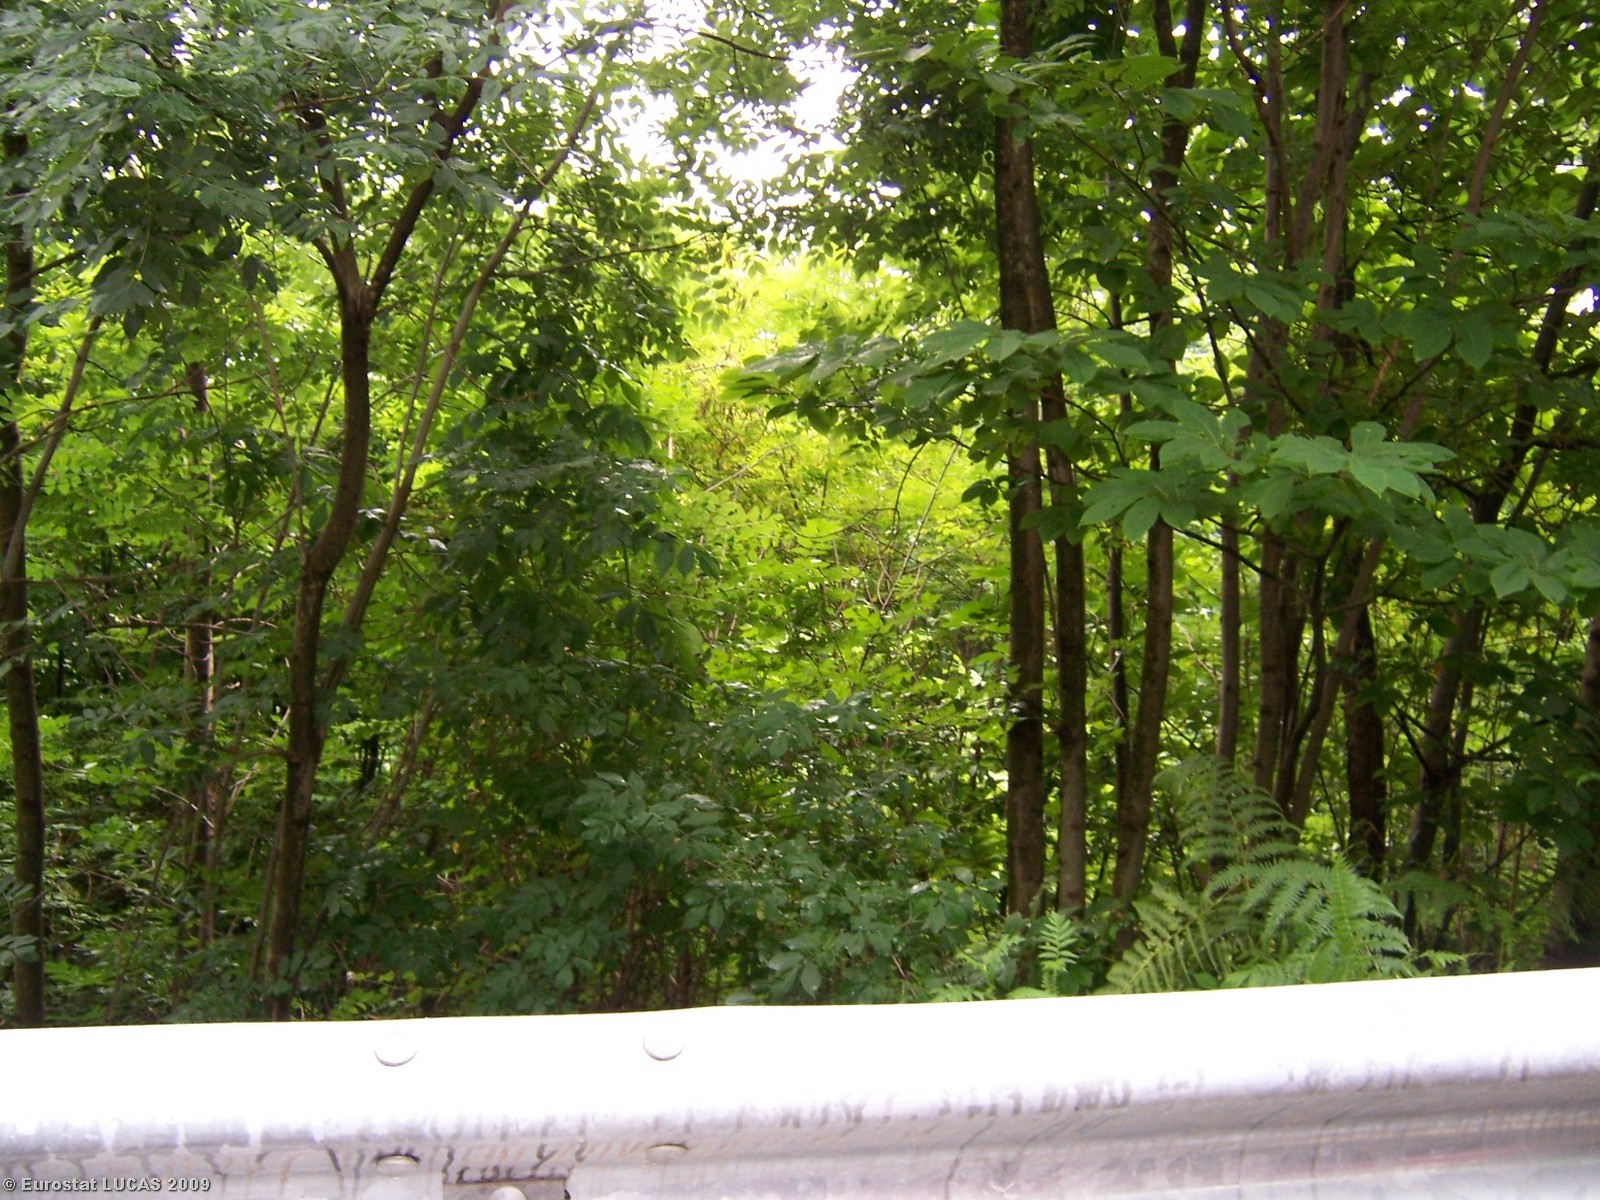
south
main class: Woodland
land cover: Broadleaved woodland
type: mesophytic deciduous forest
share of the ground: 50 - 75 %
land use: Unused
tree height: > 5 m
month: July
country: IT
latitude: 45.0197
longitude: 7.3270
